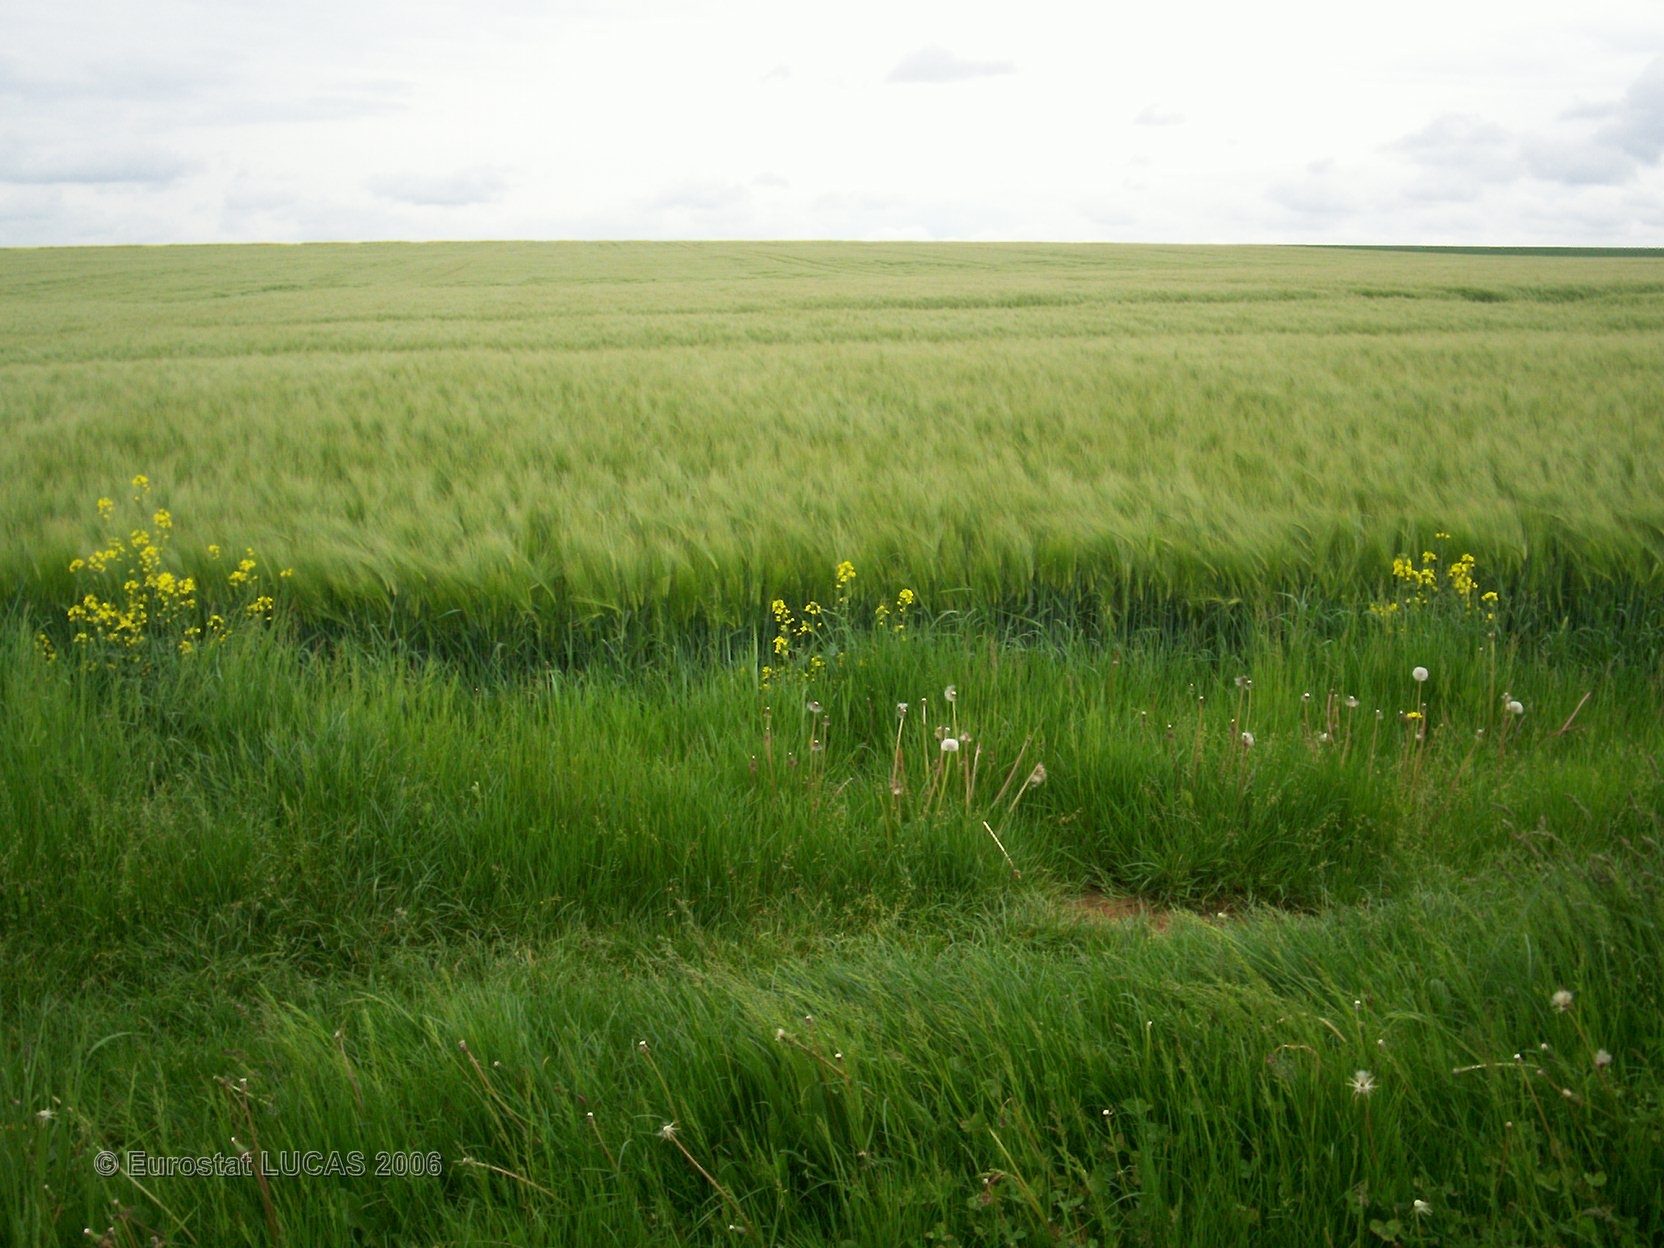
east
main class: Cropland
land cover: Rape and turnip rape
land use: Agriculture (excluding fallow land and kitchen gardens)
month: May
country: FR
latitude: 48.1943
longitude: 4.4954
